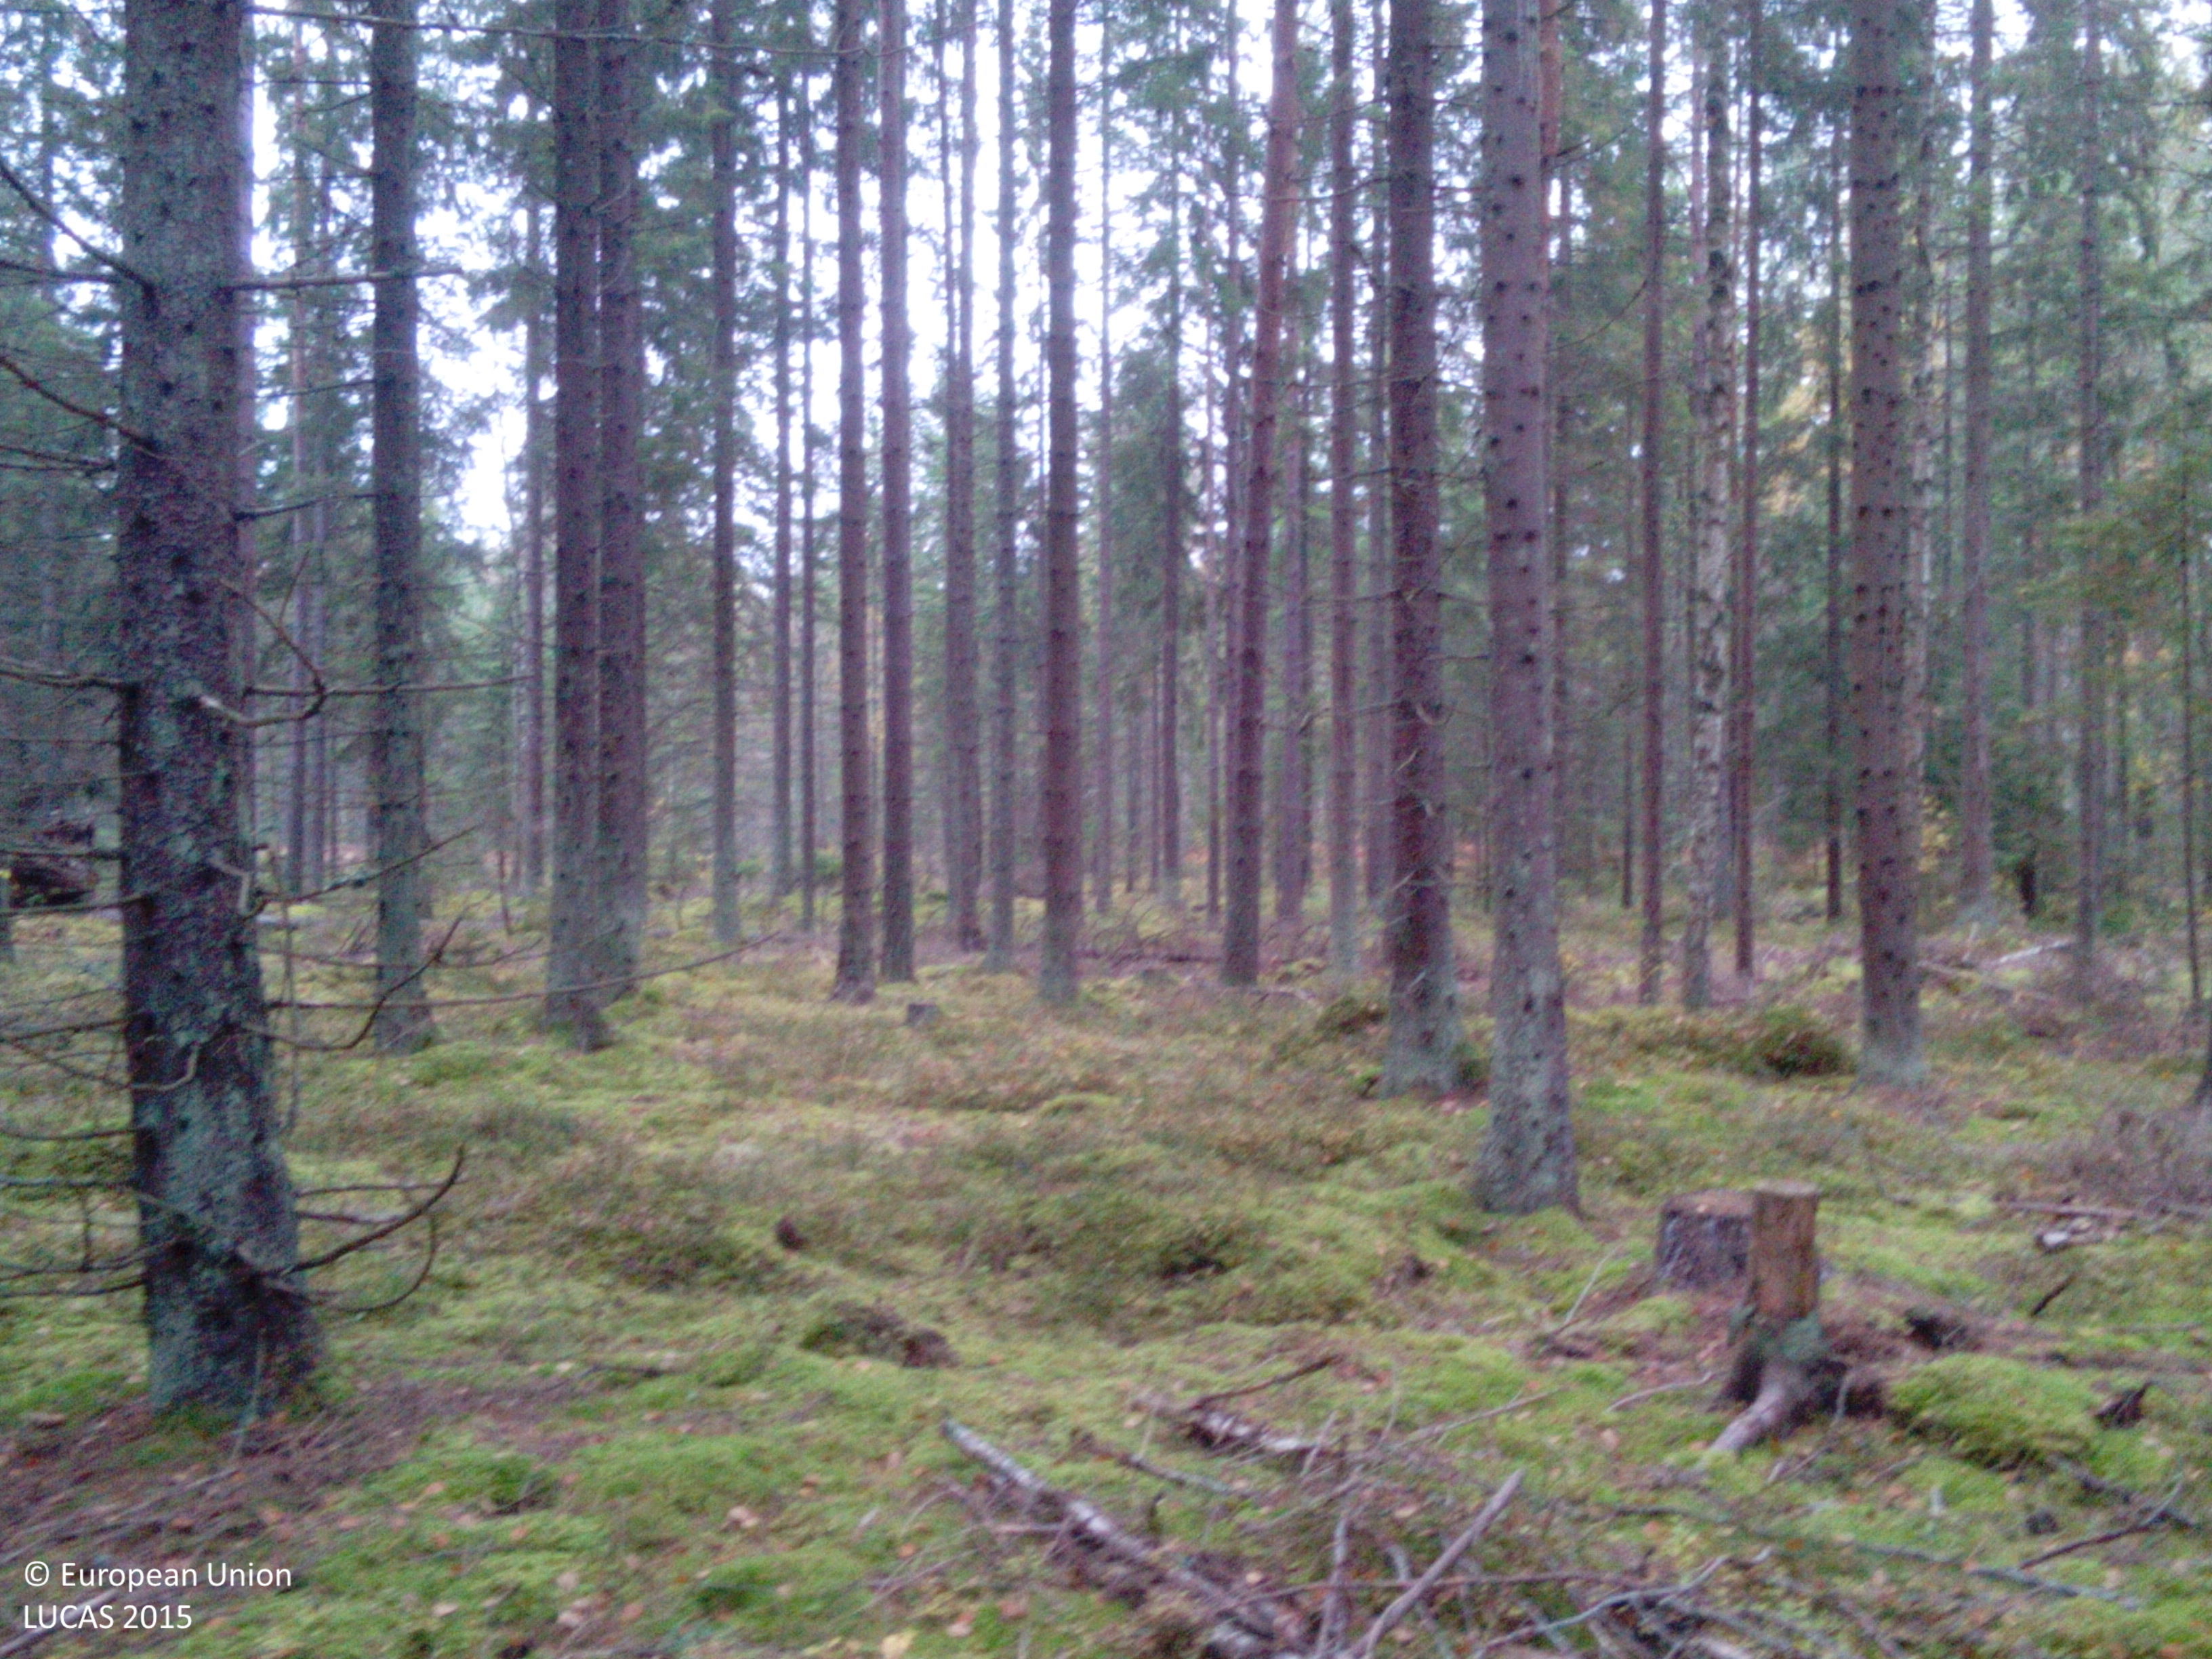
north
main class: Woodland
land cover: Spruce dominated coniferous woodland
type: boreal forest
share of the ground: > 75 %
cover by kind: coniferous forest trees 75 %, lichens and mosses 15 %, broadleaved forest trees 10 %
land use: Forestry
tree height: > 5 m
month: October
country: SE
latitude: 59.0699
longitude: 16.1856
